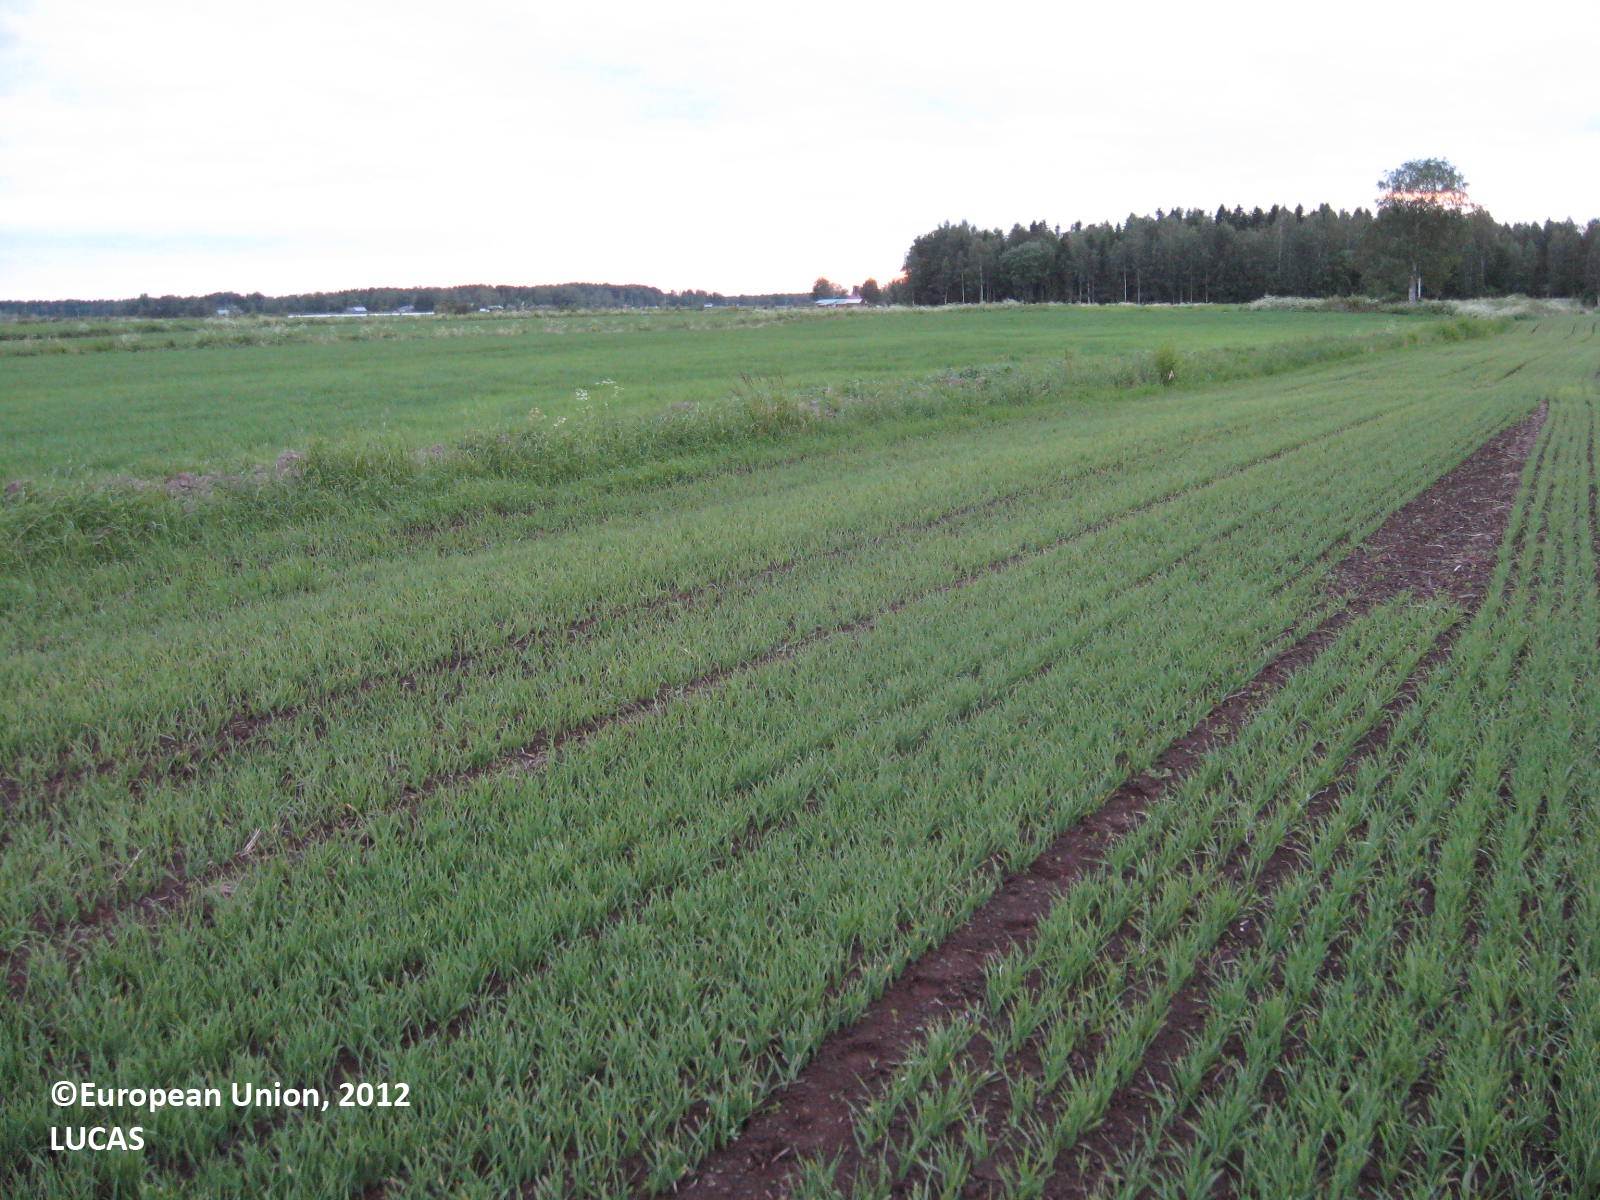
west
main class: Cropland
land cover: Barley
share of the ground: 50 - 75 %
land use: Agriculture (excluding fallow land and kitchen gardens)
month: June
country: FI
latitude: 62.8537
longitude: 22.7671
